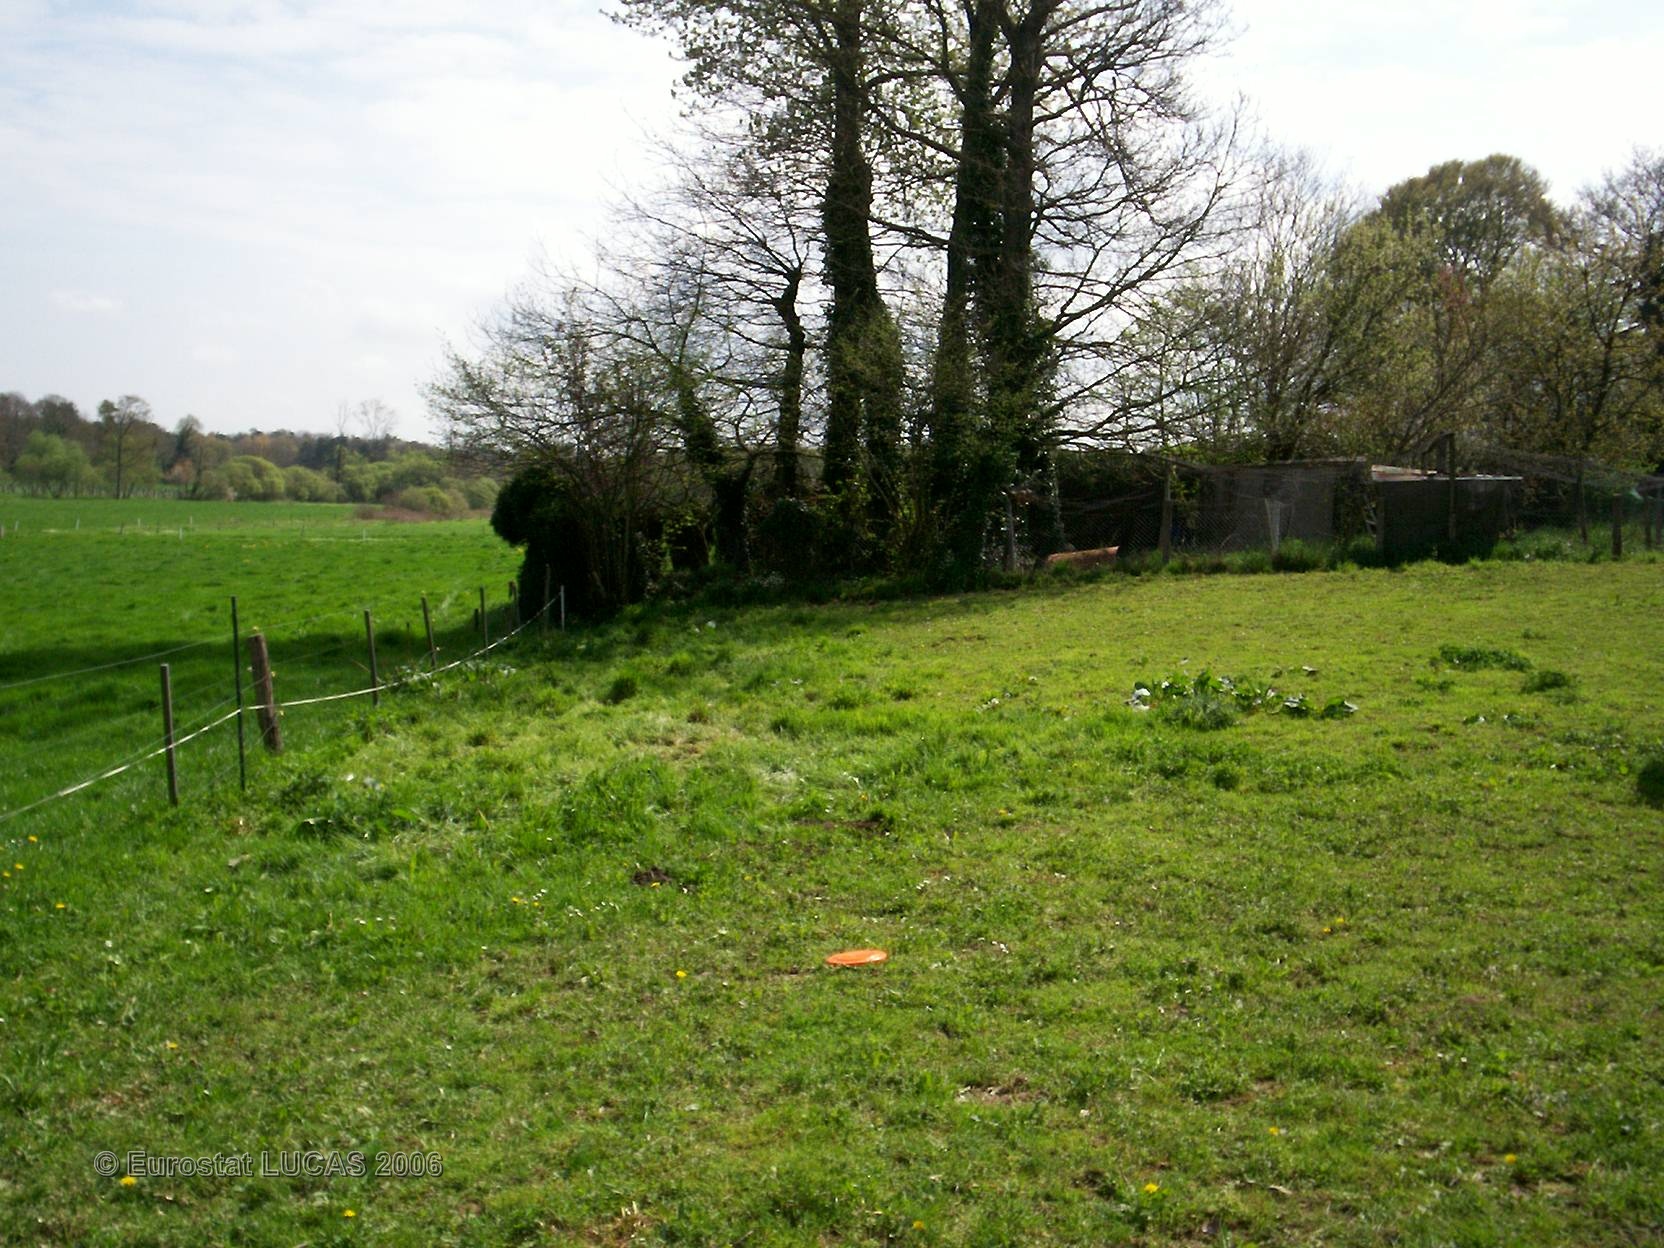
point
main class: Grassland
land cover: Grassland without tree/shrub cover
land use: Agriculture (excluding fallow land and kitchen gardens)
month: April
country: FR
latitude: 48.0497
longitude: -2.3868
